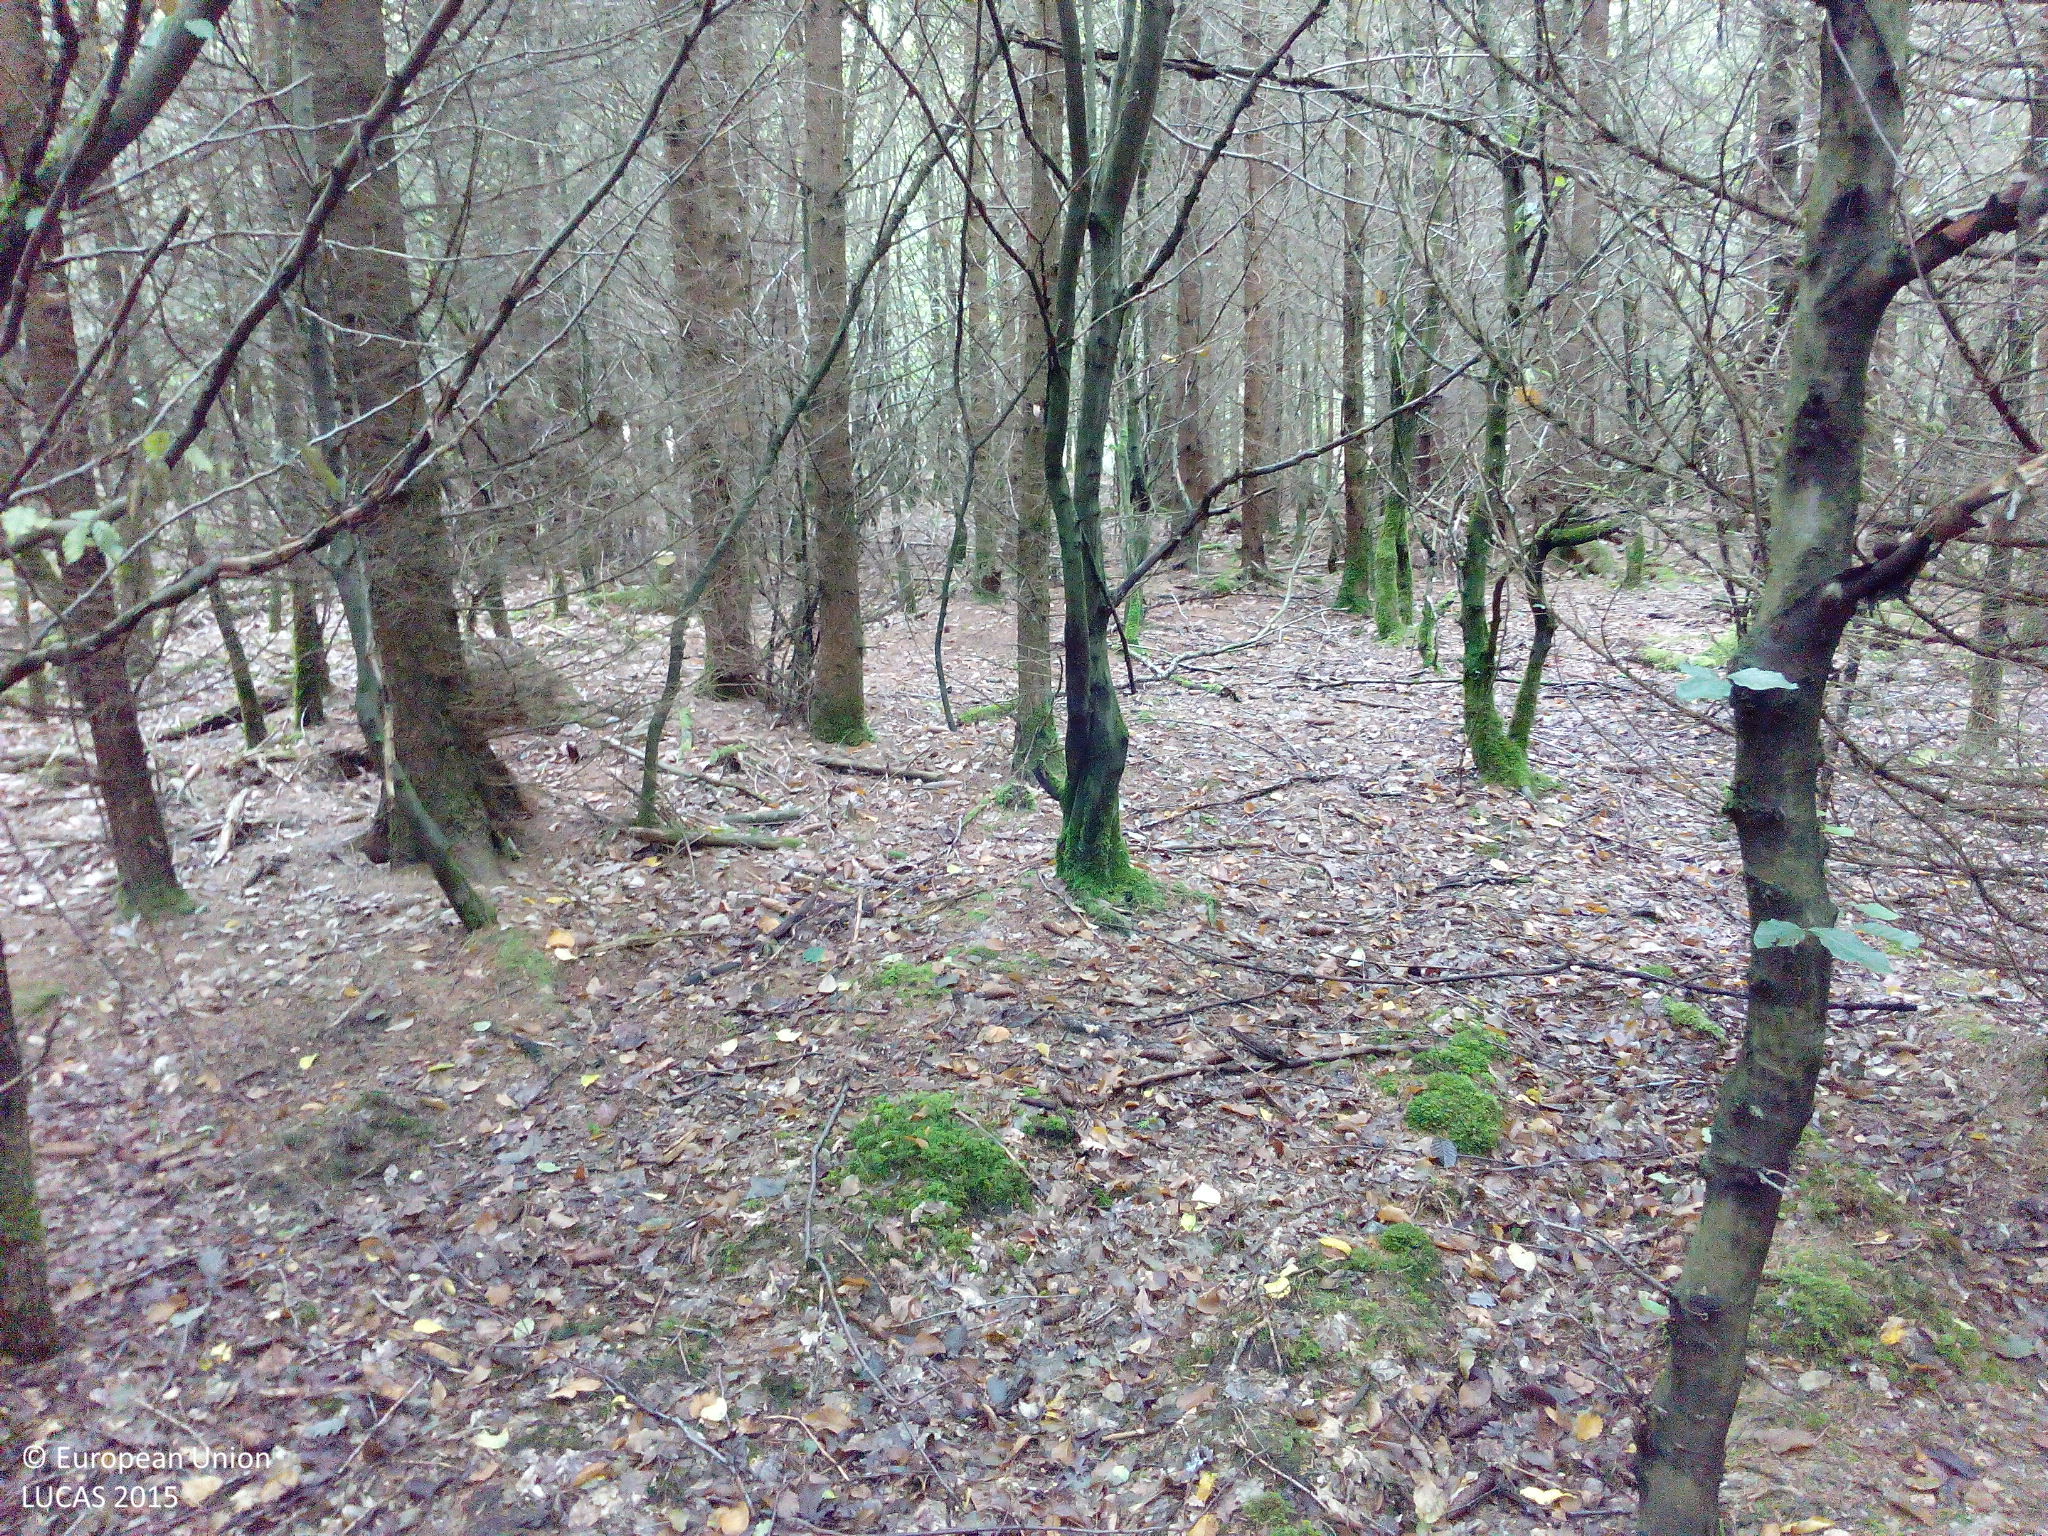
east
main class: Woodland
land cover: Spruce dominated mixed woodland
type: mesophytic deciduous forest
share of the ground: > 75 %
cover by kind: coniferous forest trees 45 %, broadleaved forest trees 45 %, unconsolidated bare surface 10 %
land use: Forestry
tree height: > 5 m
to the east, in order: Spruce dominated mixed woodland; Ditches and canals; Spruce dominated mixed woodland; Tracks; Spontaneously vegetated surfaces; Spruce dominated mixed woodland; Tracks; Grassland without tree/shrub cover; Other coniferous woodland; Broadleaved woodland
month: August
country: DE
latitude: 50.0687
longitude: 7.5833
